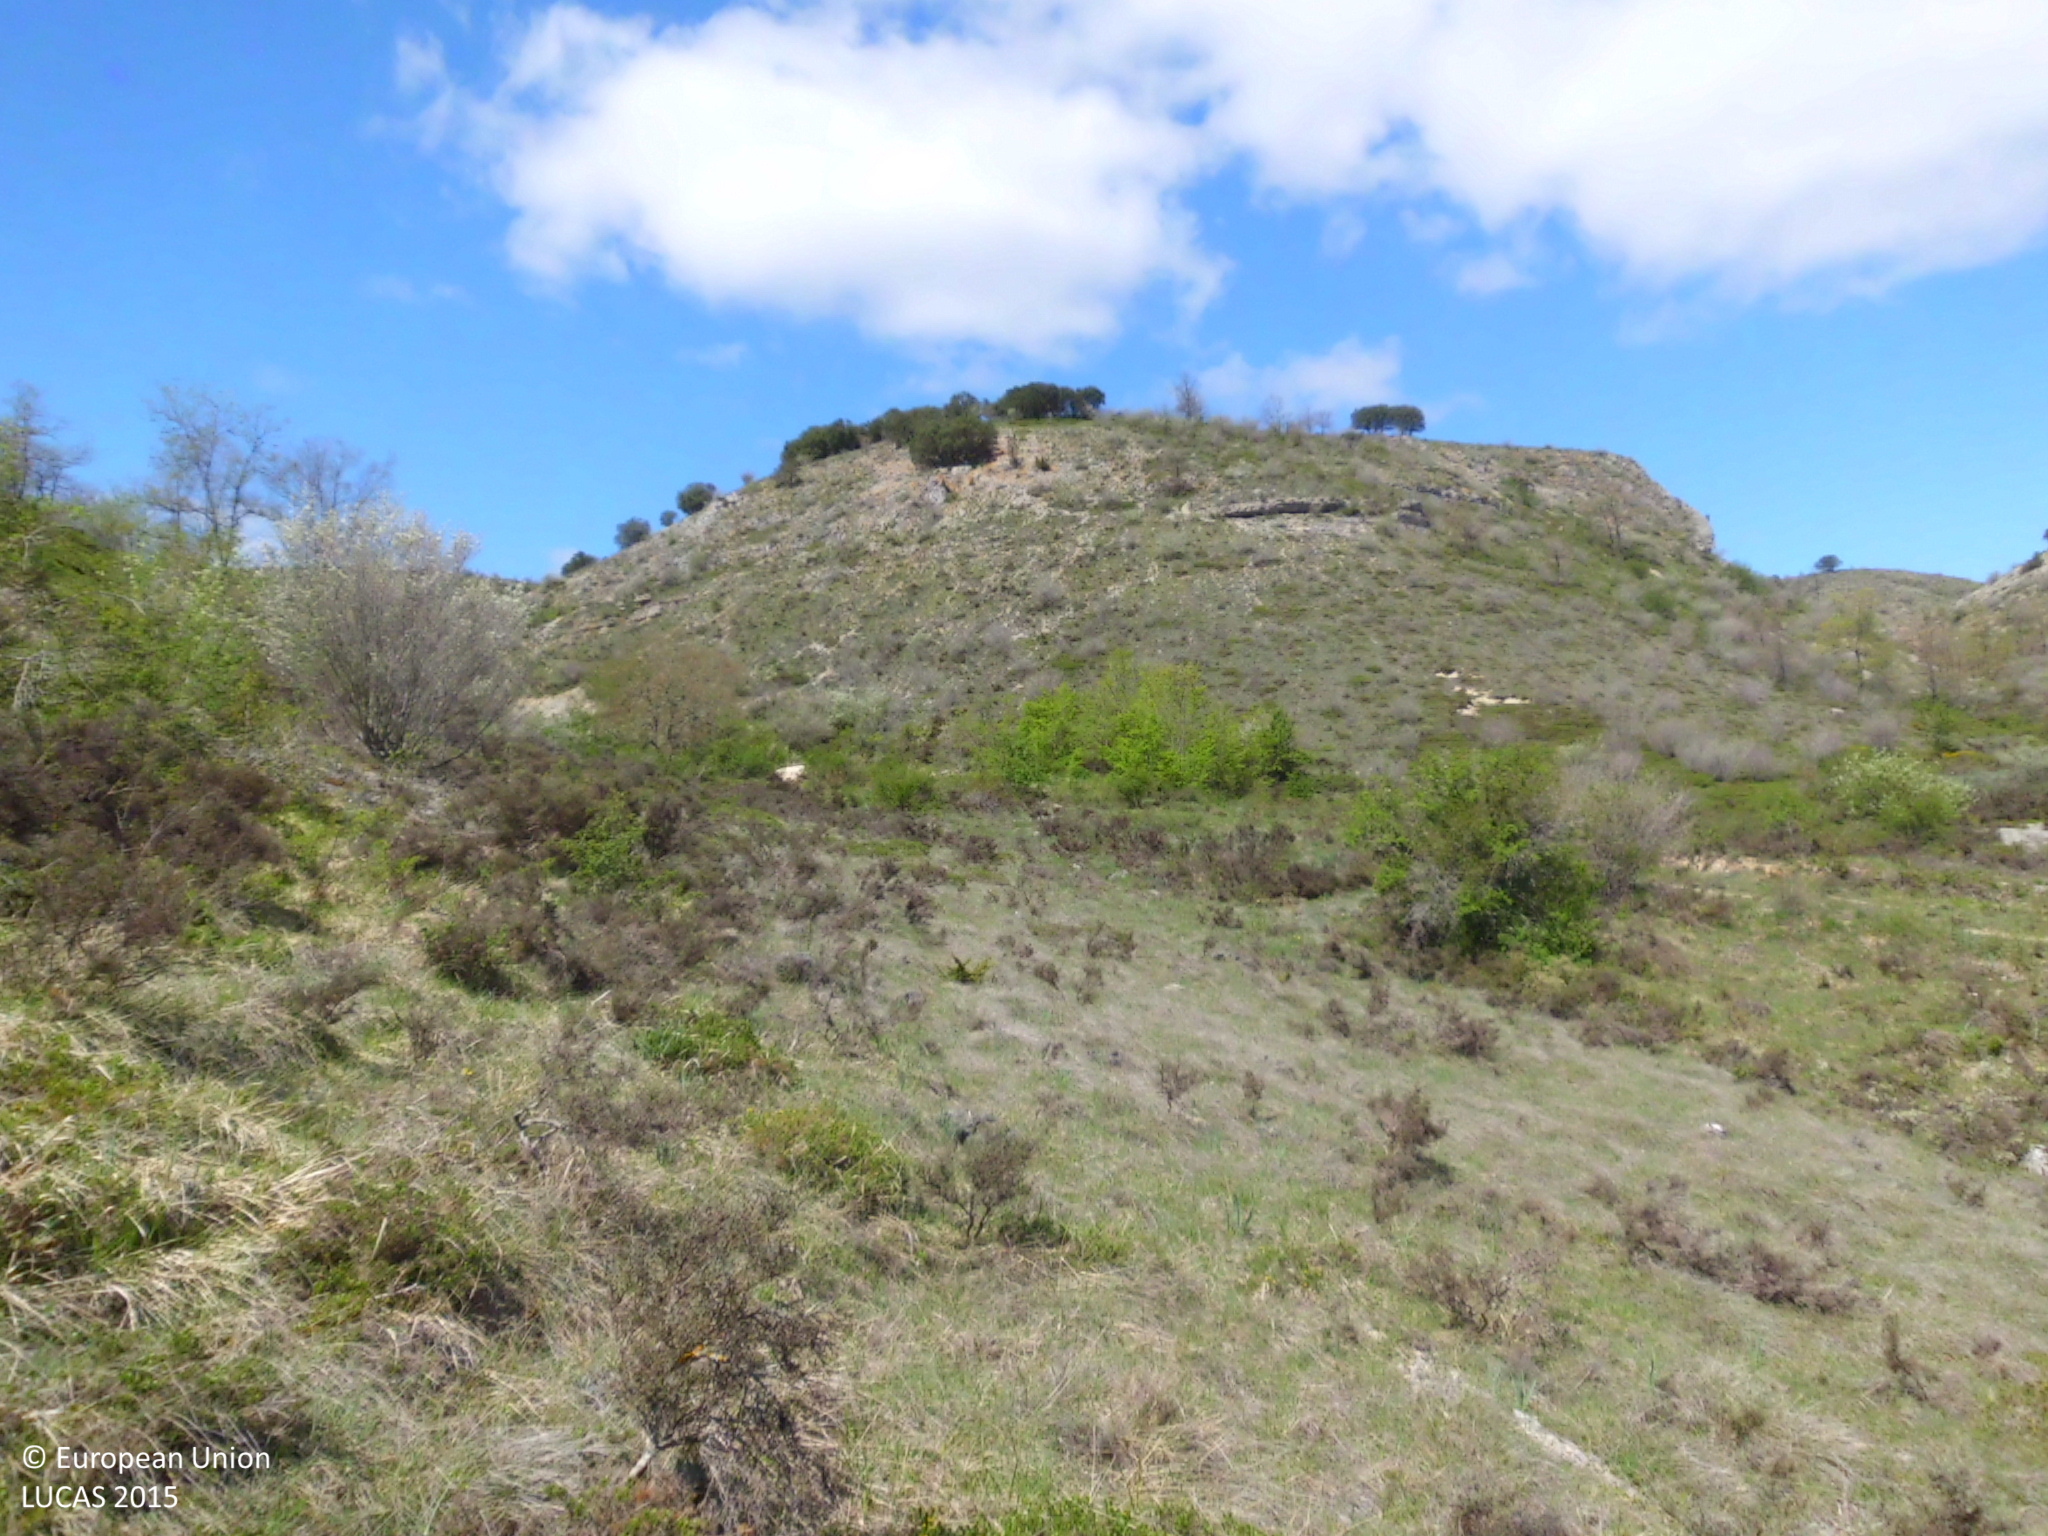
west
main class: Shrubland
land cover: Shrubland without tree cover
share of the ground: 25 - 50 %
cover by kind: herbaceous plants 60 %, shrubs 40 %
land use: Semi-natural and natural areas not in use
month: May
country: ES
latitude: 42.7522
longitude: -3.7620
